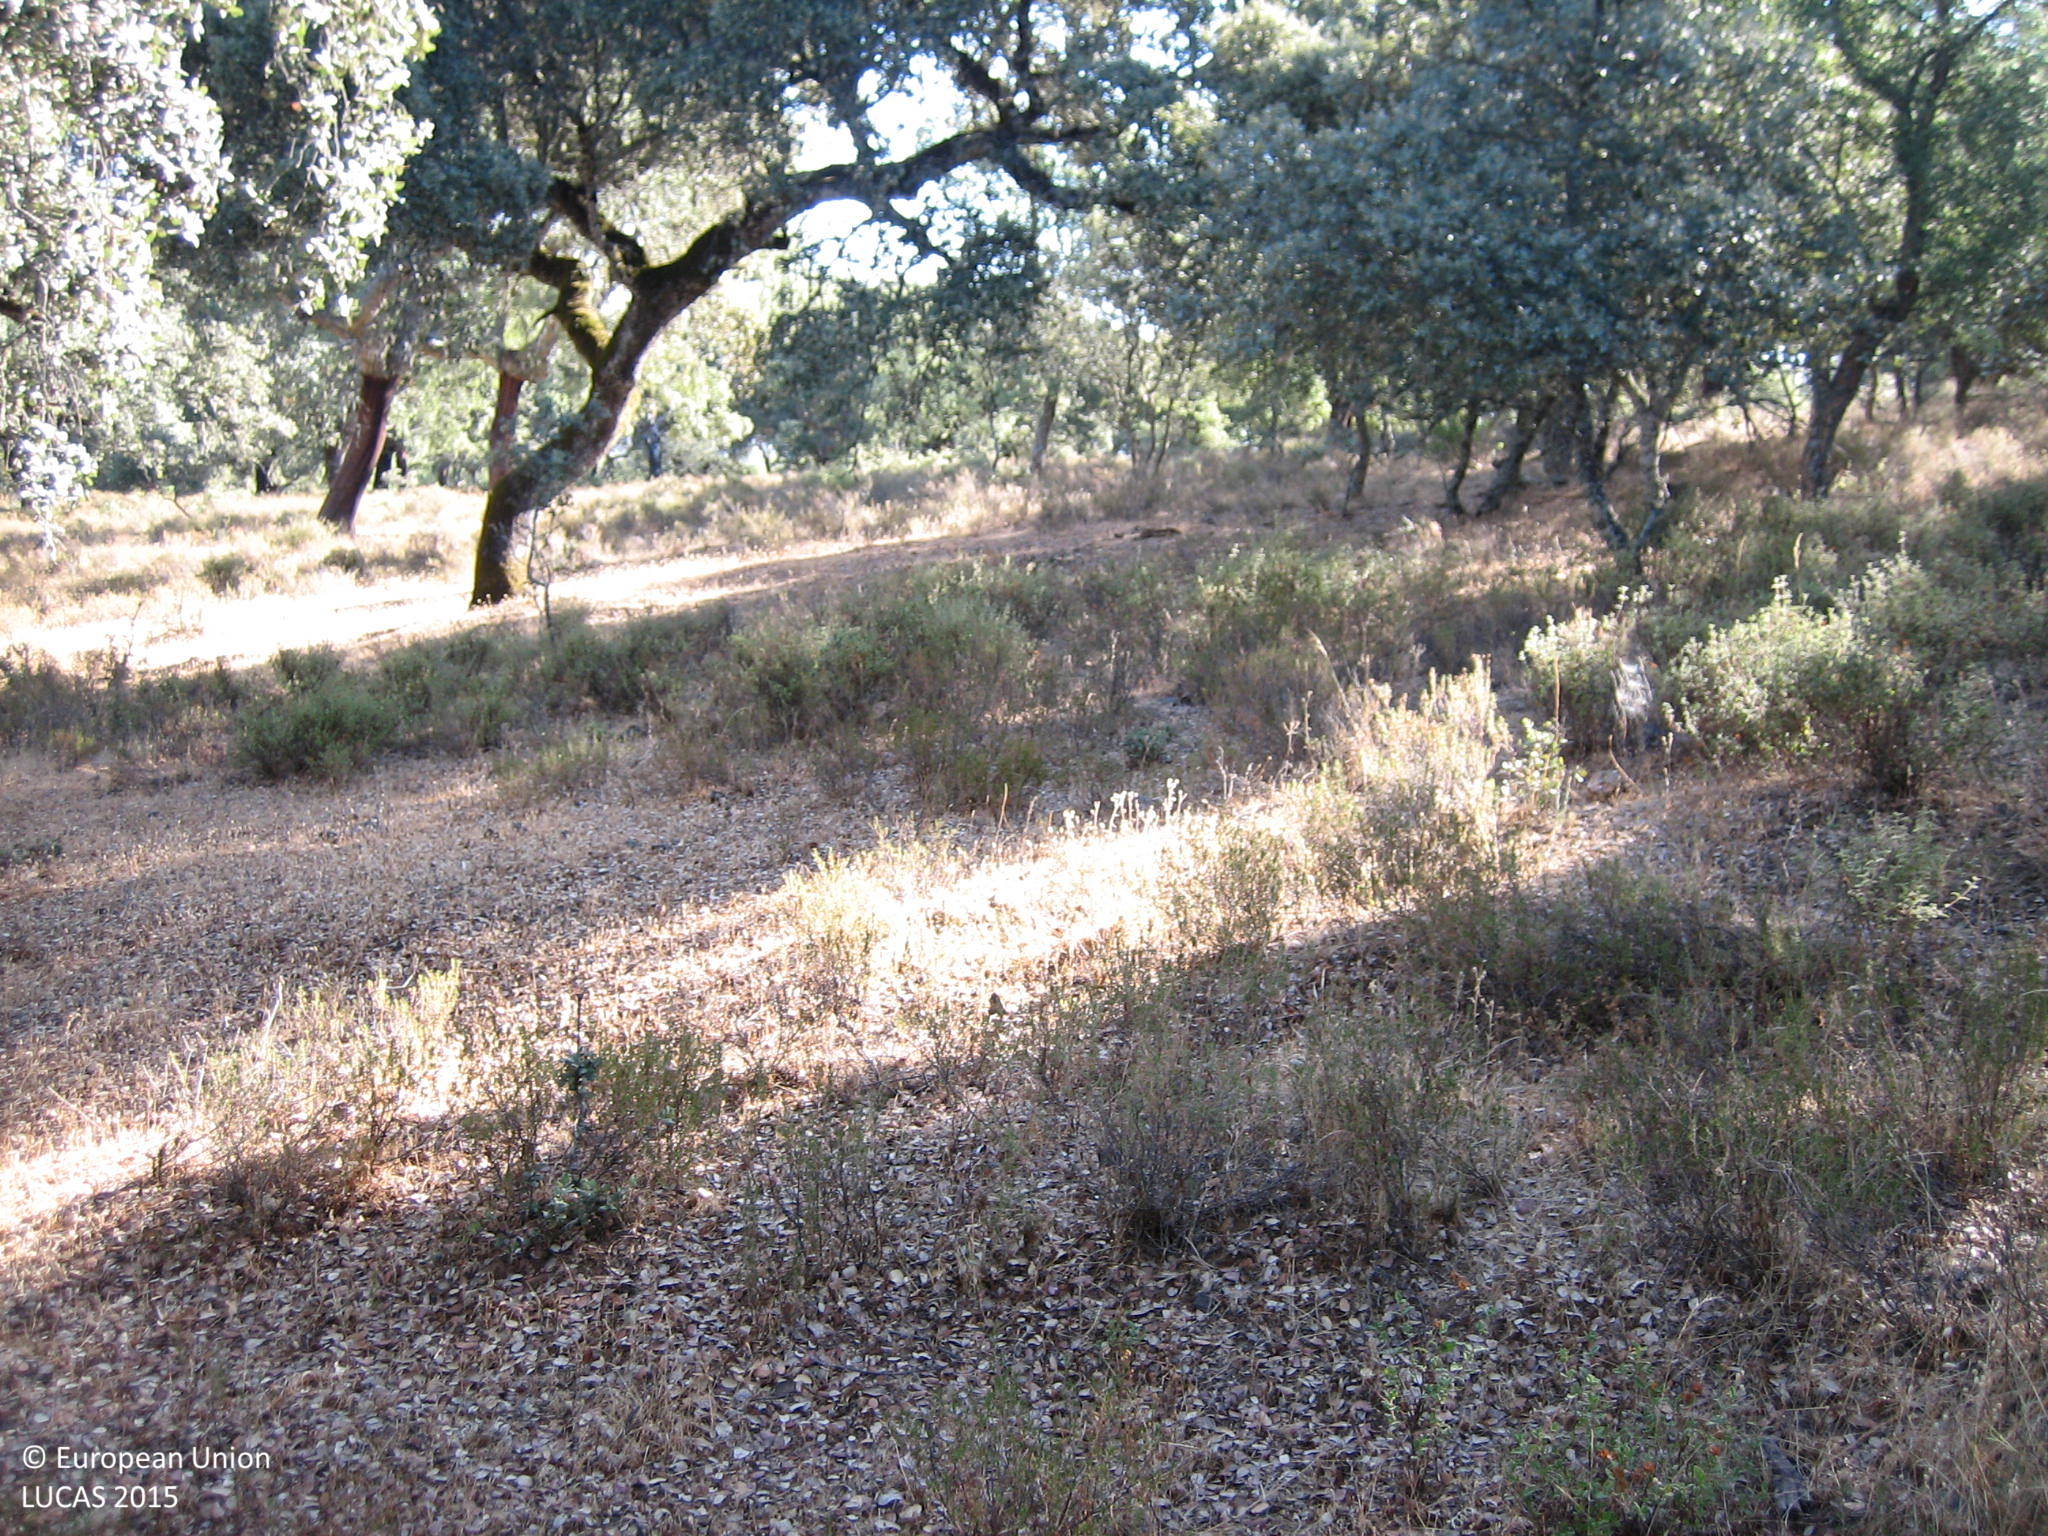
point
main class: Woodland
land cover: Broadleaved woodland
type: broadleaved evergreen forest
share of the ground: 50 - 75 %
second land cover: Shrubland without tree cover
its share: 25 - 50 %
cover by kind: broadleaved forest trees 60 %, shrubs 30 %, herbaceous plants 10 %
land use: Forestry
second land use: Agriculture (excluding fallow land and kitchen gardens)
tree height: > 5 m
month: August
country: ES
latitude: 38.0851
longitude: -6.2885
